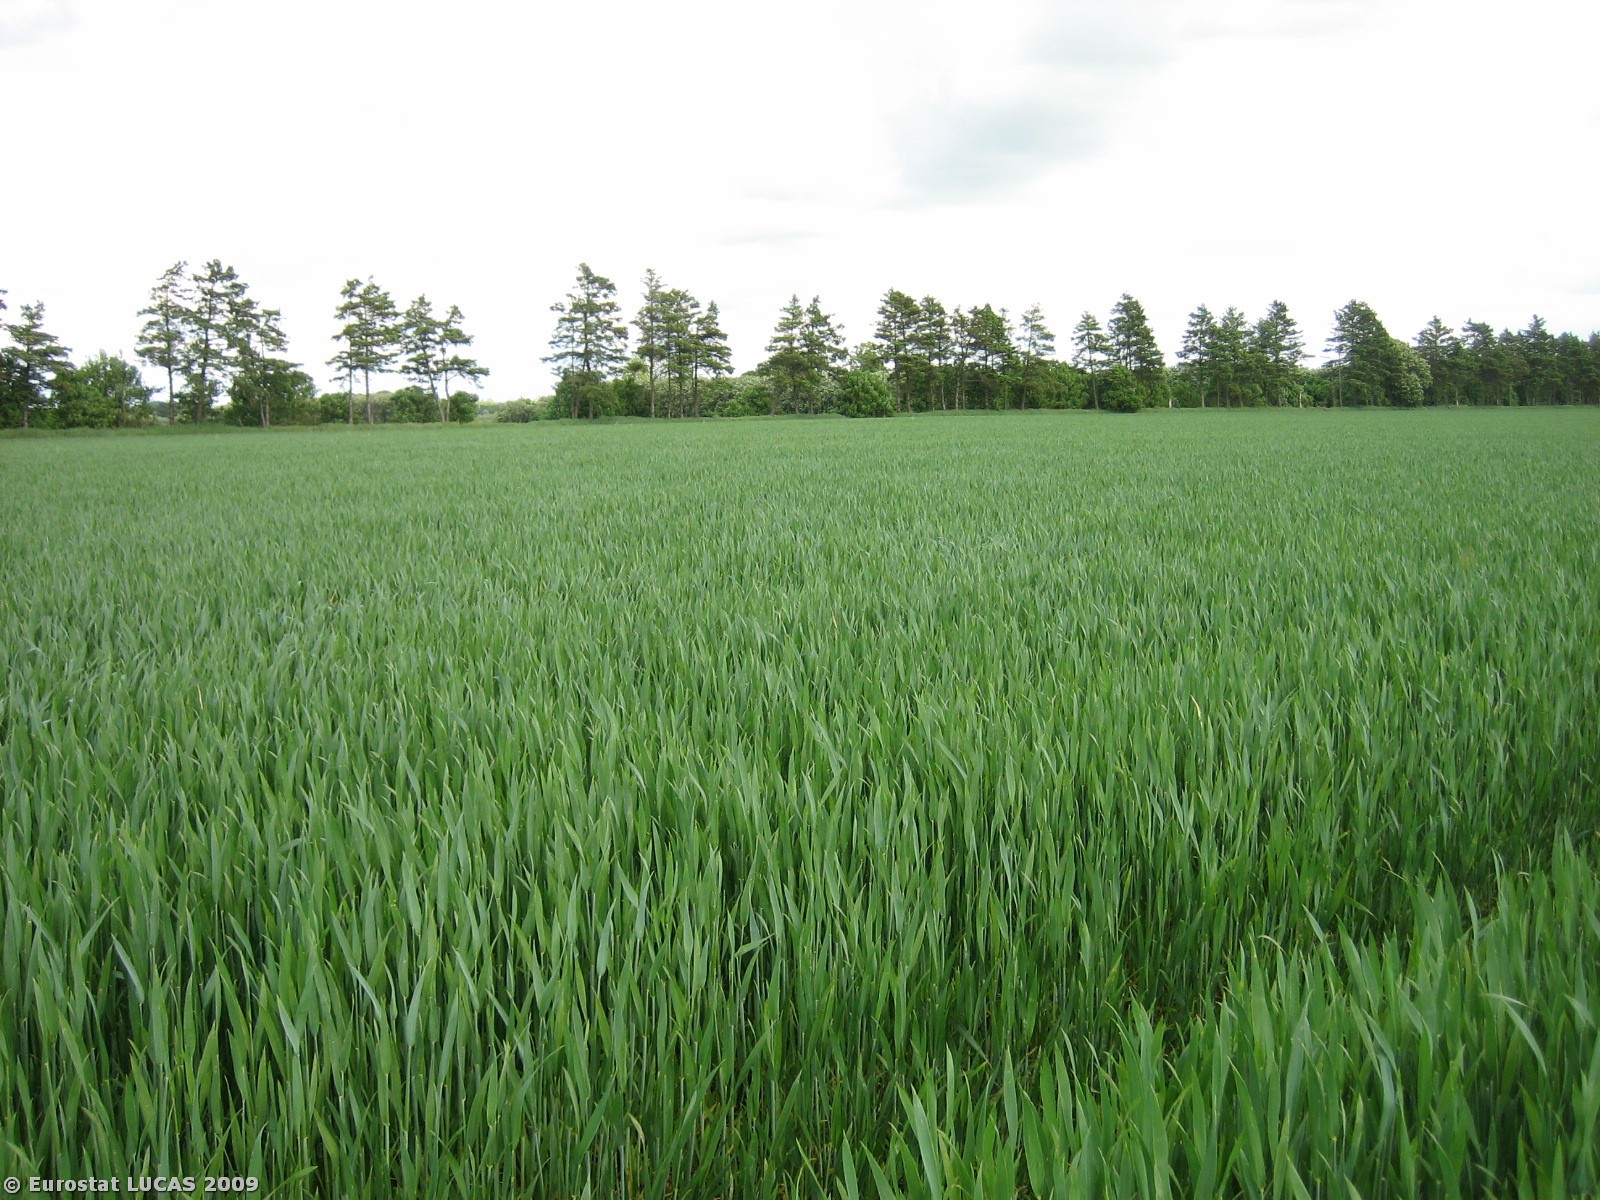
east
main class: Cropland
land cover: Barley
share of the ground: > 75 %
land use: Agriculture (excluding fallow land and kitchen gardens)
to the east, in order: Barley; Grass margins; Coniferous woodland; Shrubland with sparse tree cover; Rye
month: May
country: DK
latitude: 56.0206
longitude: 8.8301
